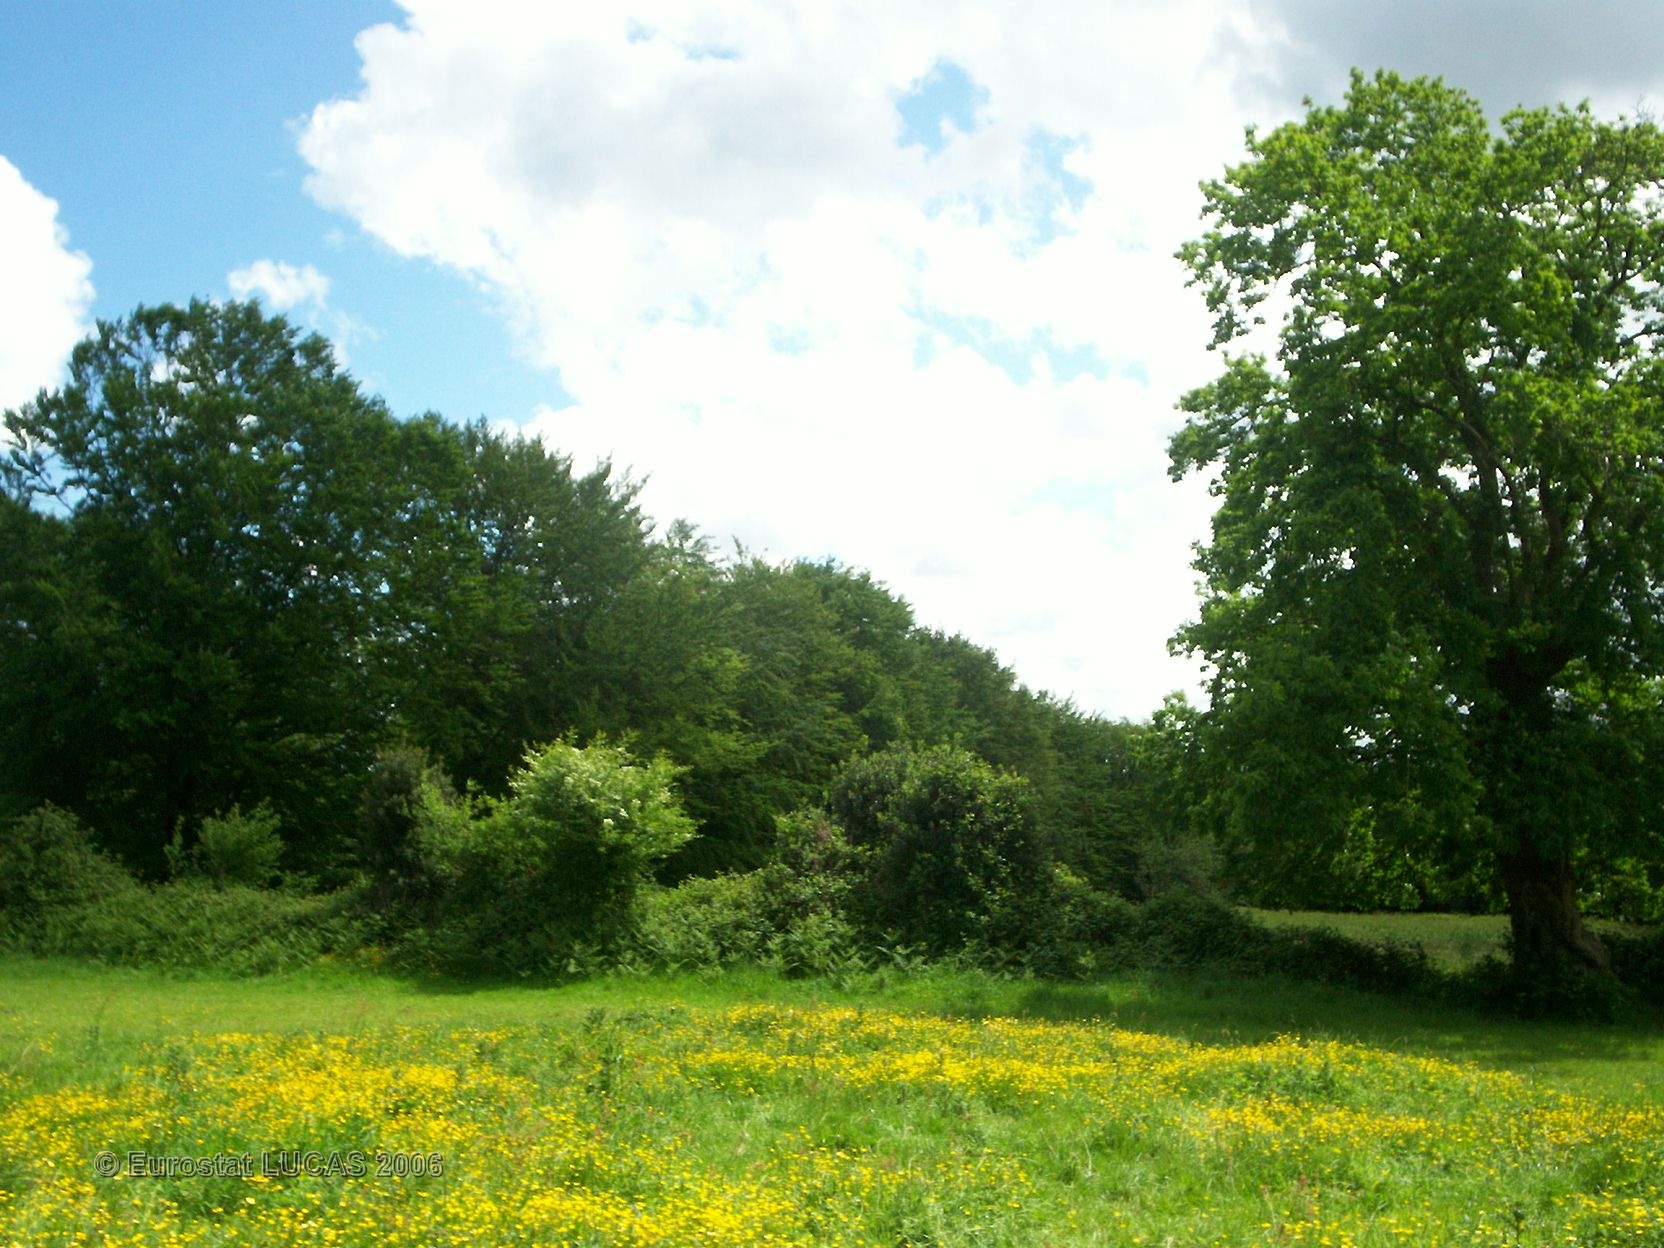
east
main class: Grassland
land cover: Grassland without tree/shrub cover
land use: Agriculture (excluding fallow land and kitchen gardens)
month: May
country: FR
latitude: 49.5868
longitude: -1.6292
